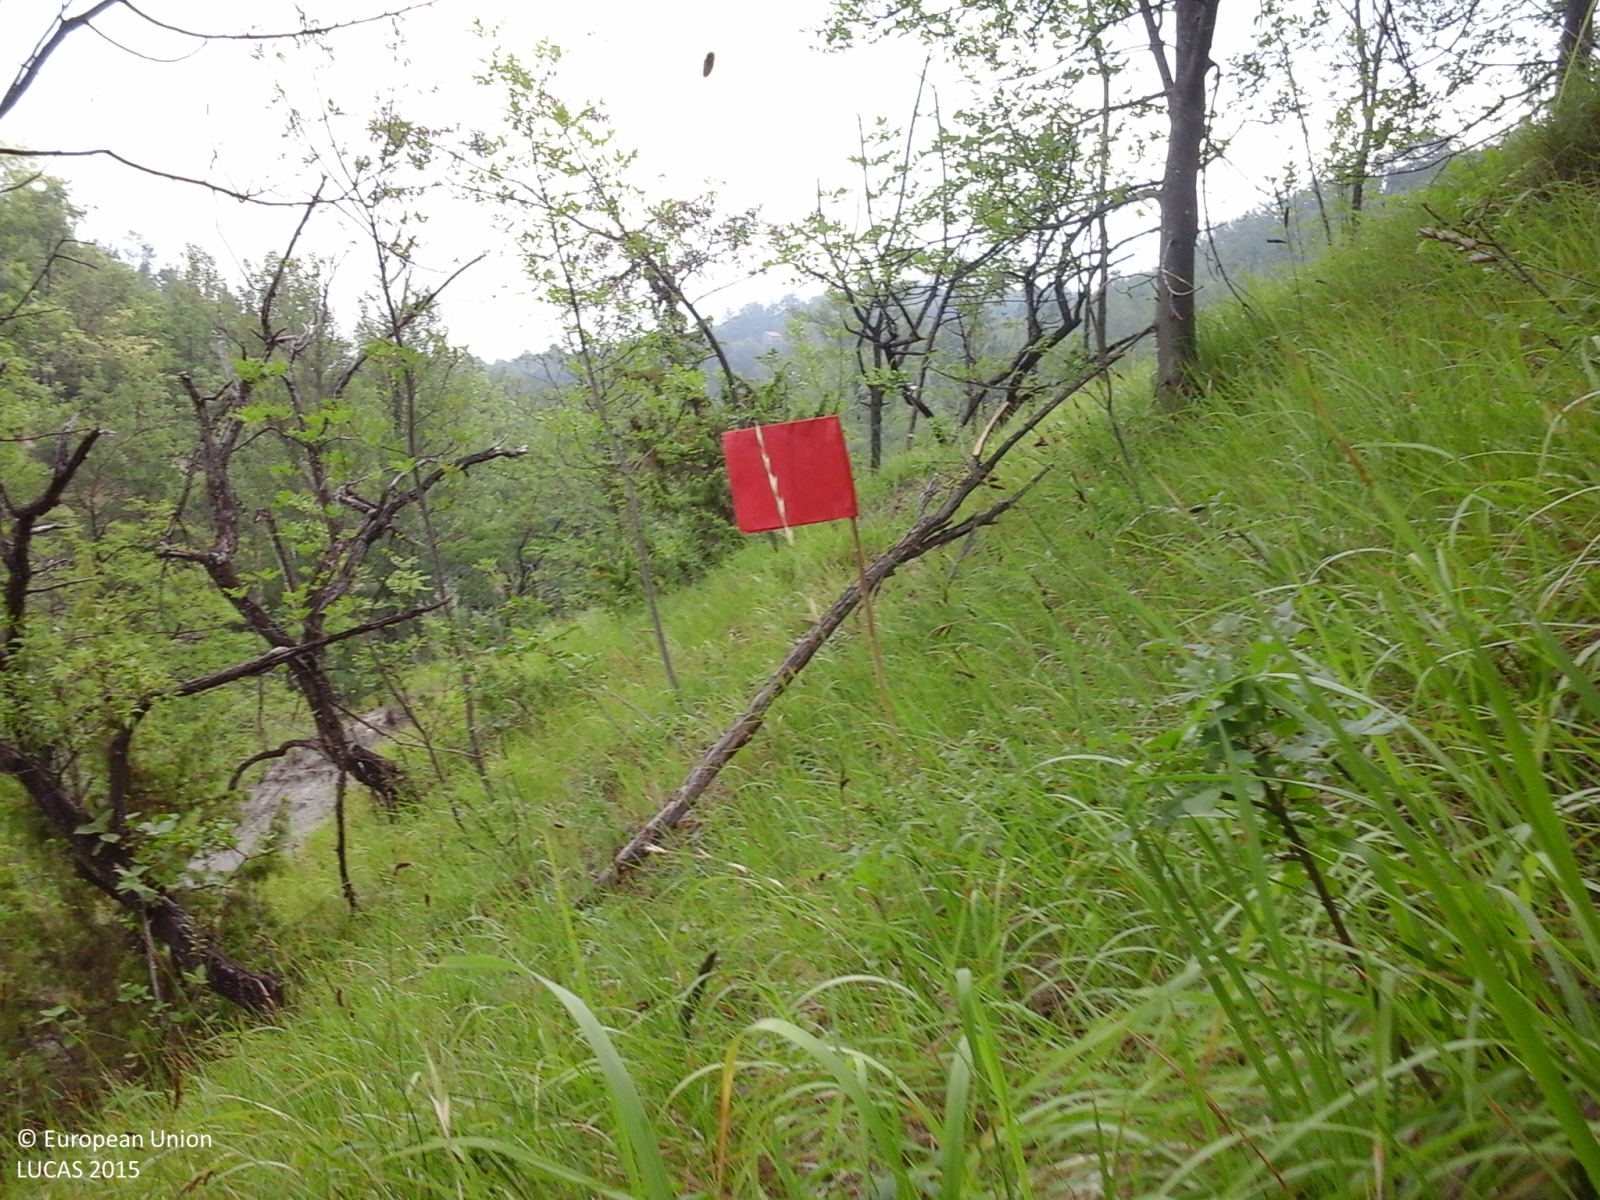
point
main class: Woodland
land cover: Broadleaved woodland
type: thermophilous deciduous forest
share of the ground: > 75 %
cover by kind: broadleaved forest trees 65 %, herbaceous plants 25 %, shrubs 10 %
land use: Forestry
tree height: < 5 m
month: June
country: IT
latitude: 44.6107
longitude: 8.5288
